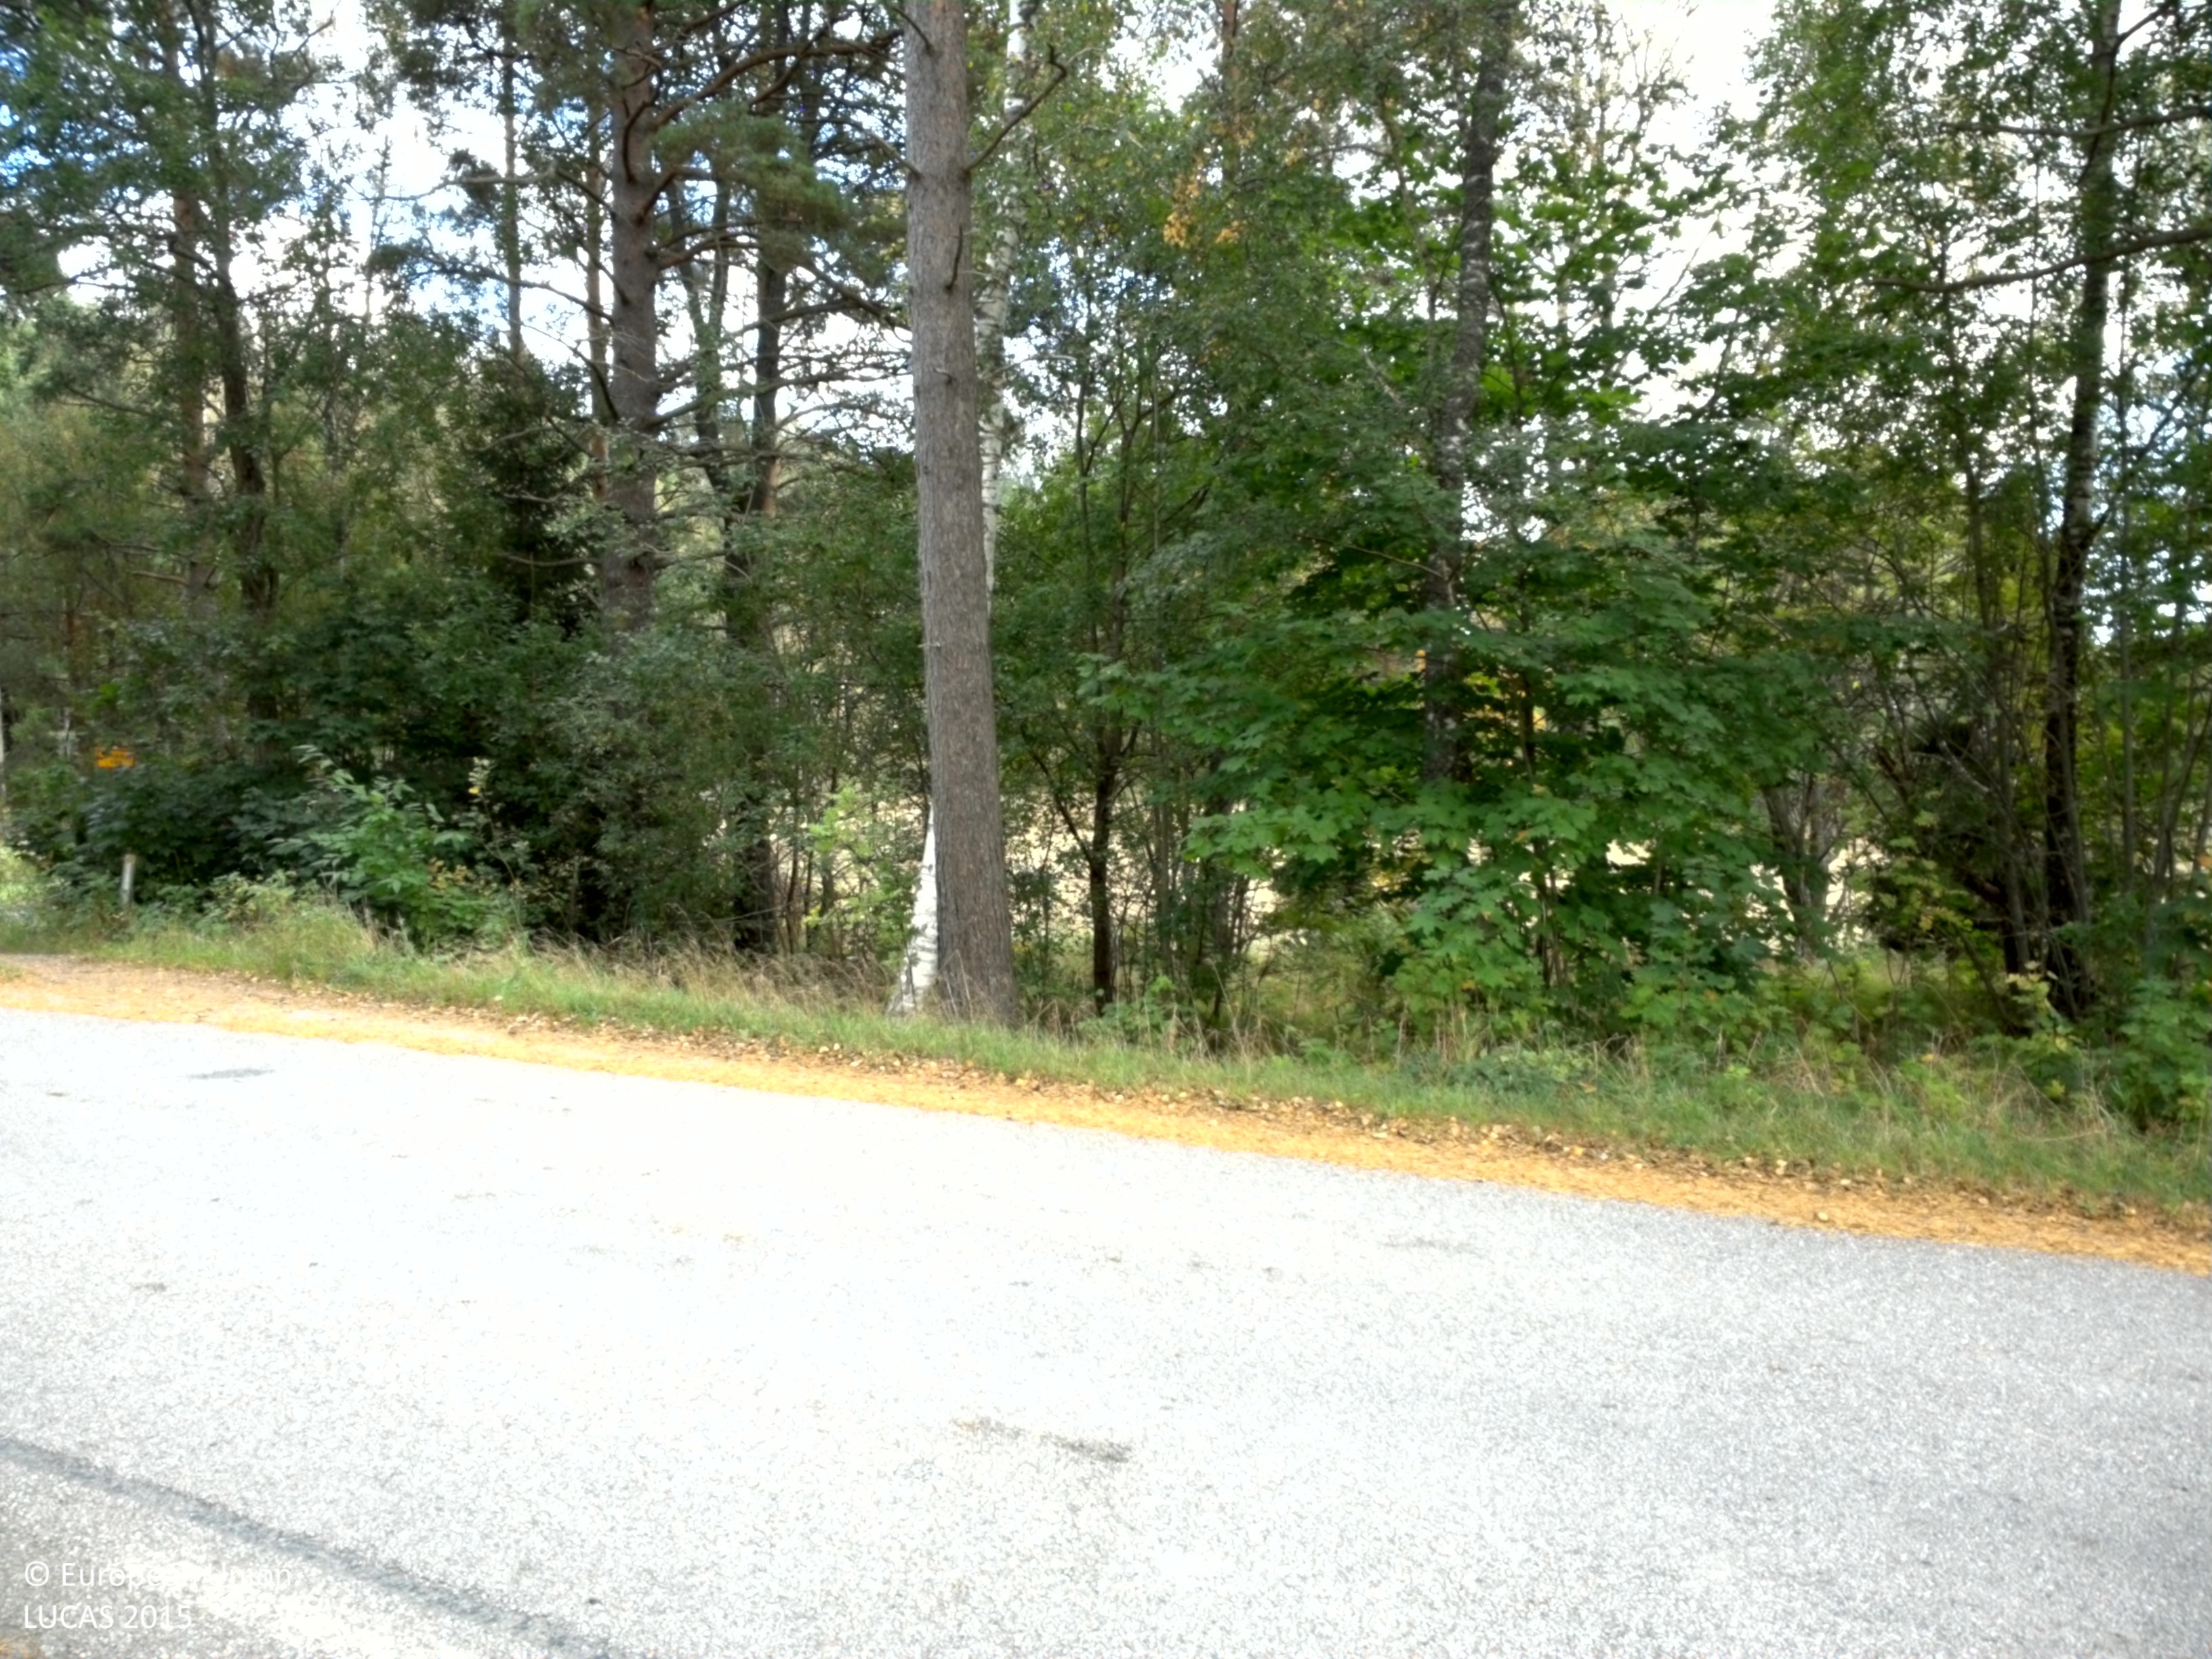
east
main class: Woodland
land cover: Broadleaved woodland
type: boreal forest
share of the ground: 50 - 75 %
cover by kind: broadleaved forest trees 75 %, herbaceous plants 25 %
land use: Forestry
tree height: > 5 m
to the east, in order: Ditches and canals; Paved roads, cycling and walking lanes; Pine dominated mixed woodland; Ditches and canals; Common wheat; Ditches and canals; Paved roads, cycling and walking lanes; Ditches and canals; Pine dominated mixed woodland; Other coniferous woodland
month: September
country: SE
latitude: 59.8510
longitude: 18.8001
